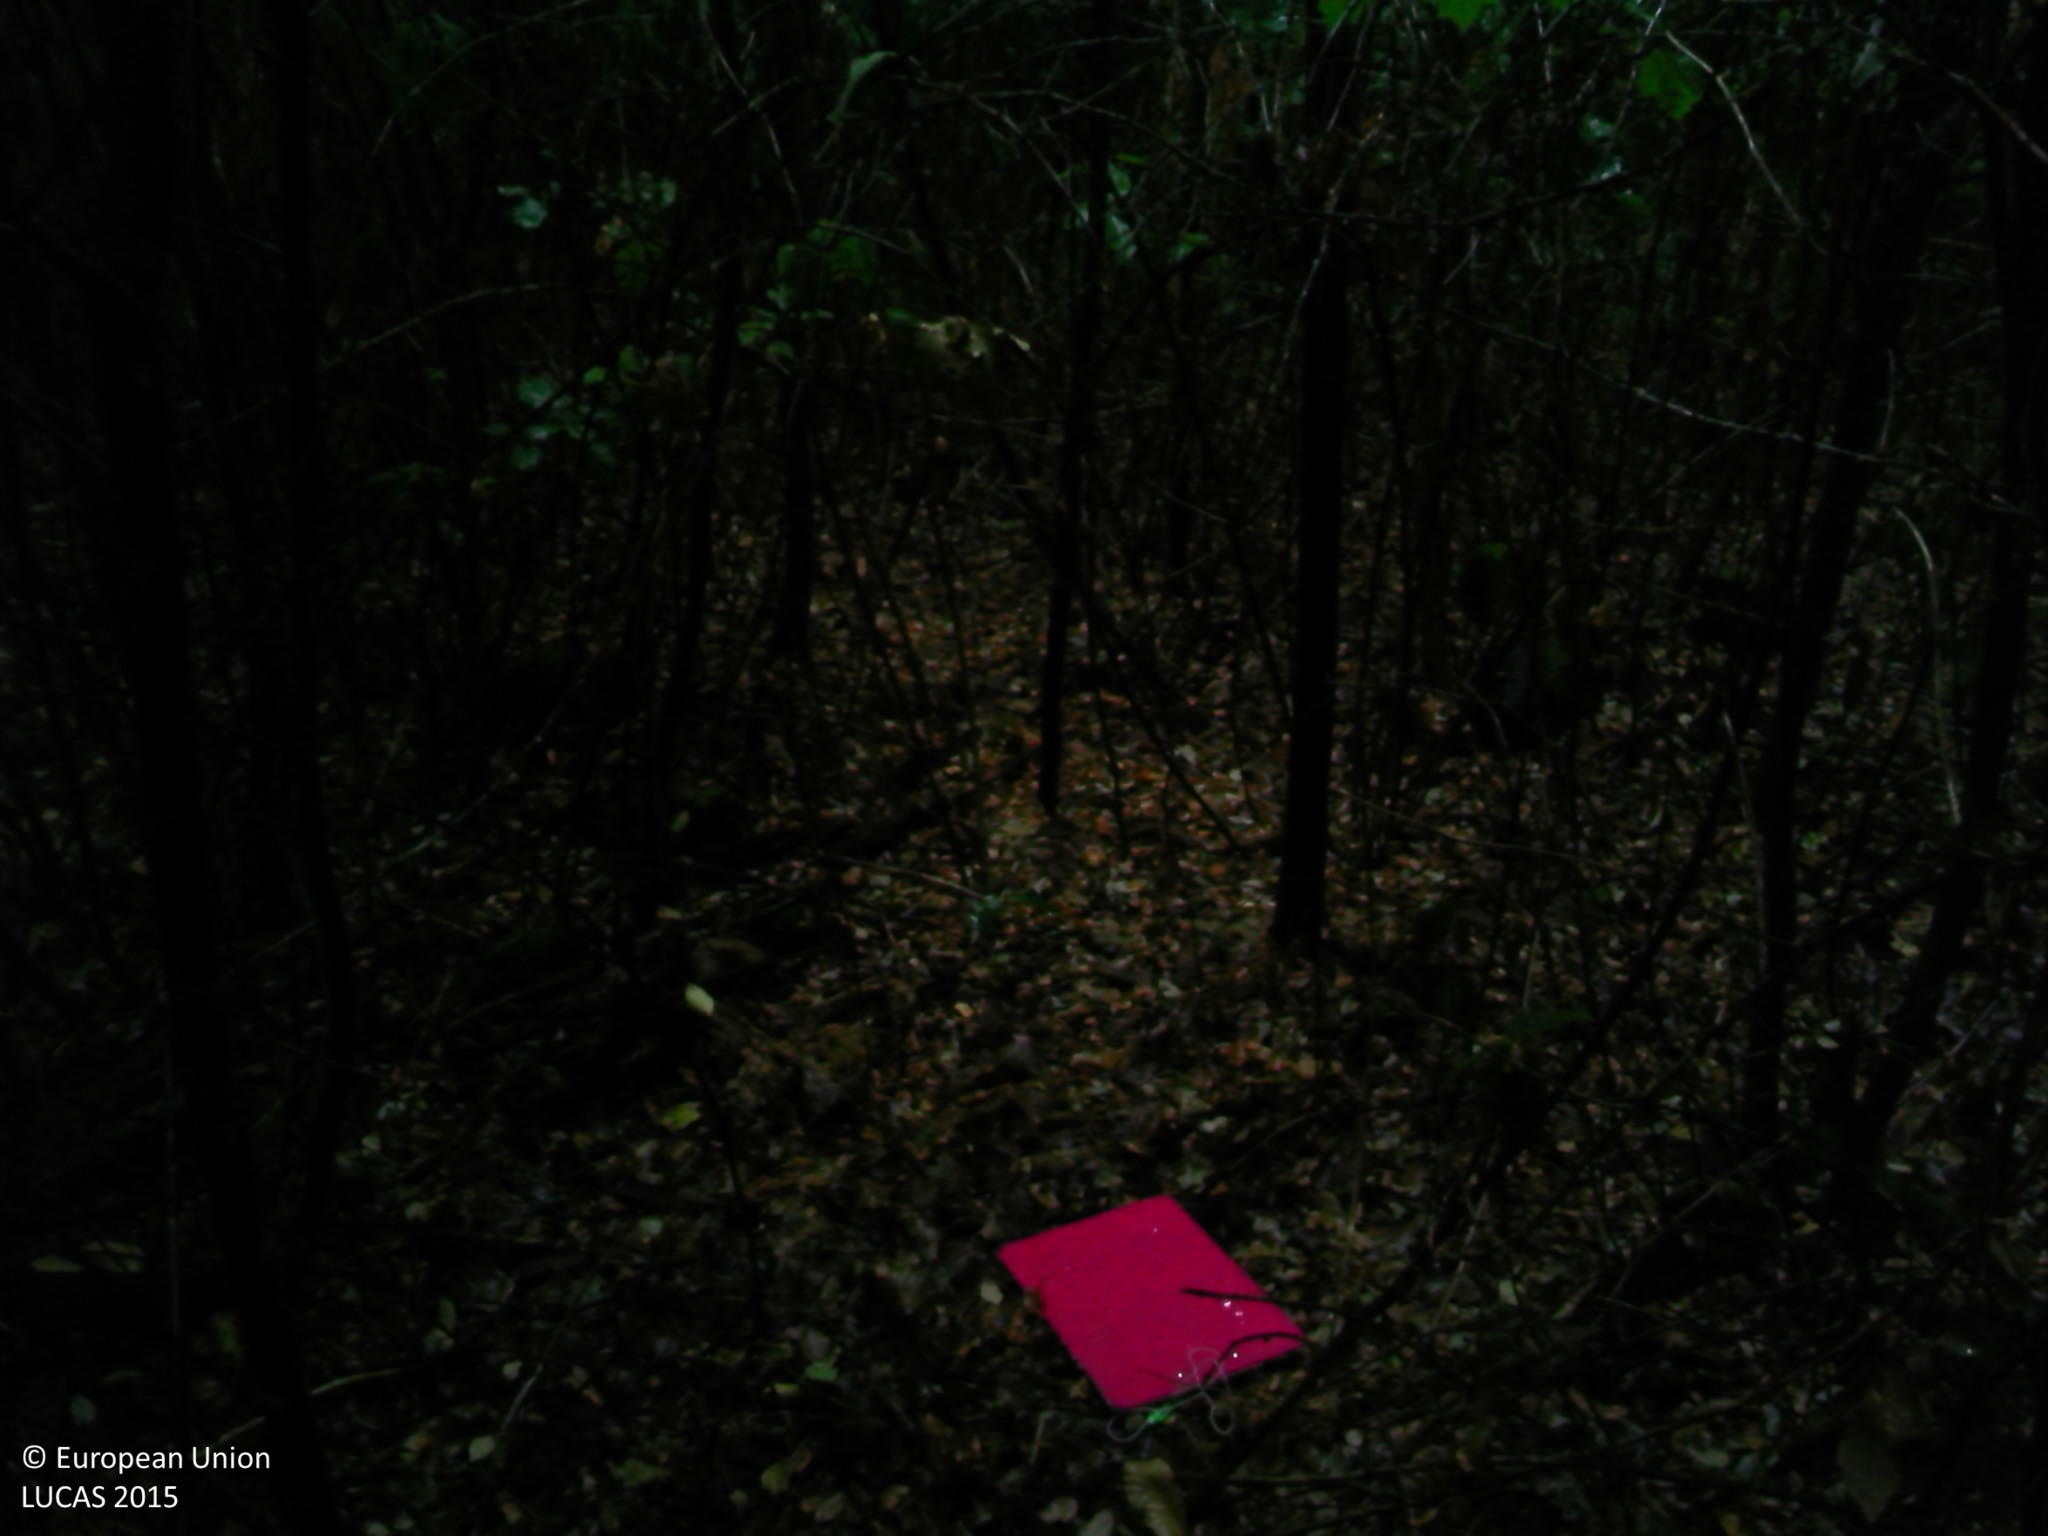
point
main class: Woodland
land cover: Broadleaved woodland
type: acidophilous oak and oak-birch forest
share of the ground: > 75 %
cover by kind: broadleaved forest trees 100 %
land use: Forestry
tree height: > 5 m
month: July
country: FR
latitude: 45.8533
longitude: 1.3239
